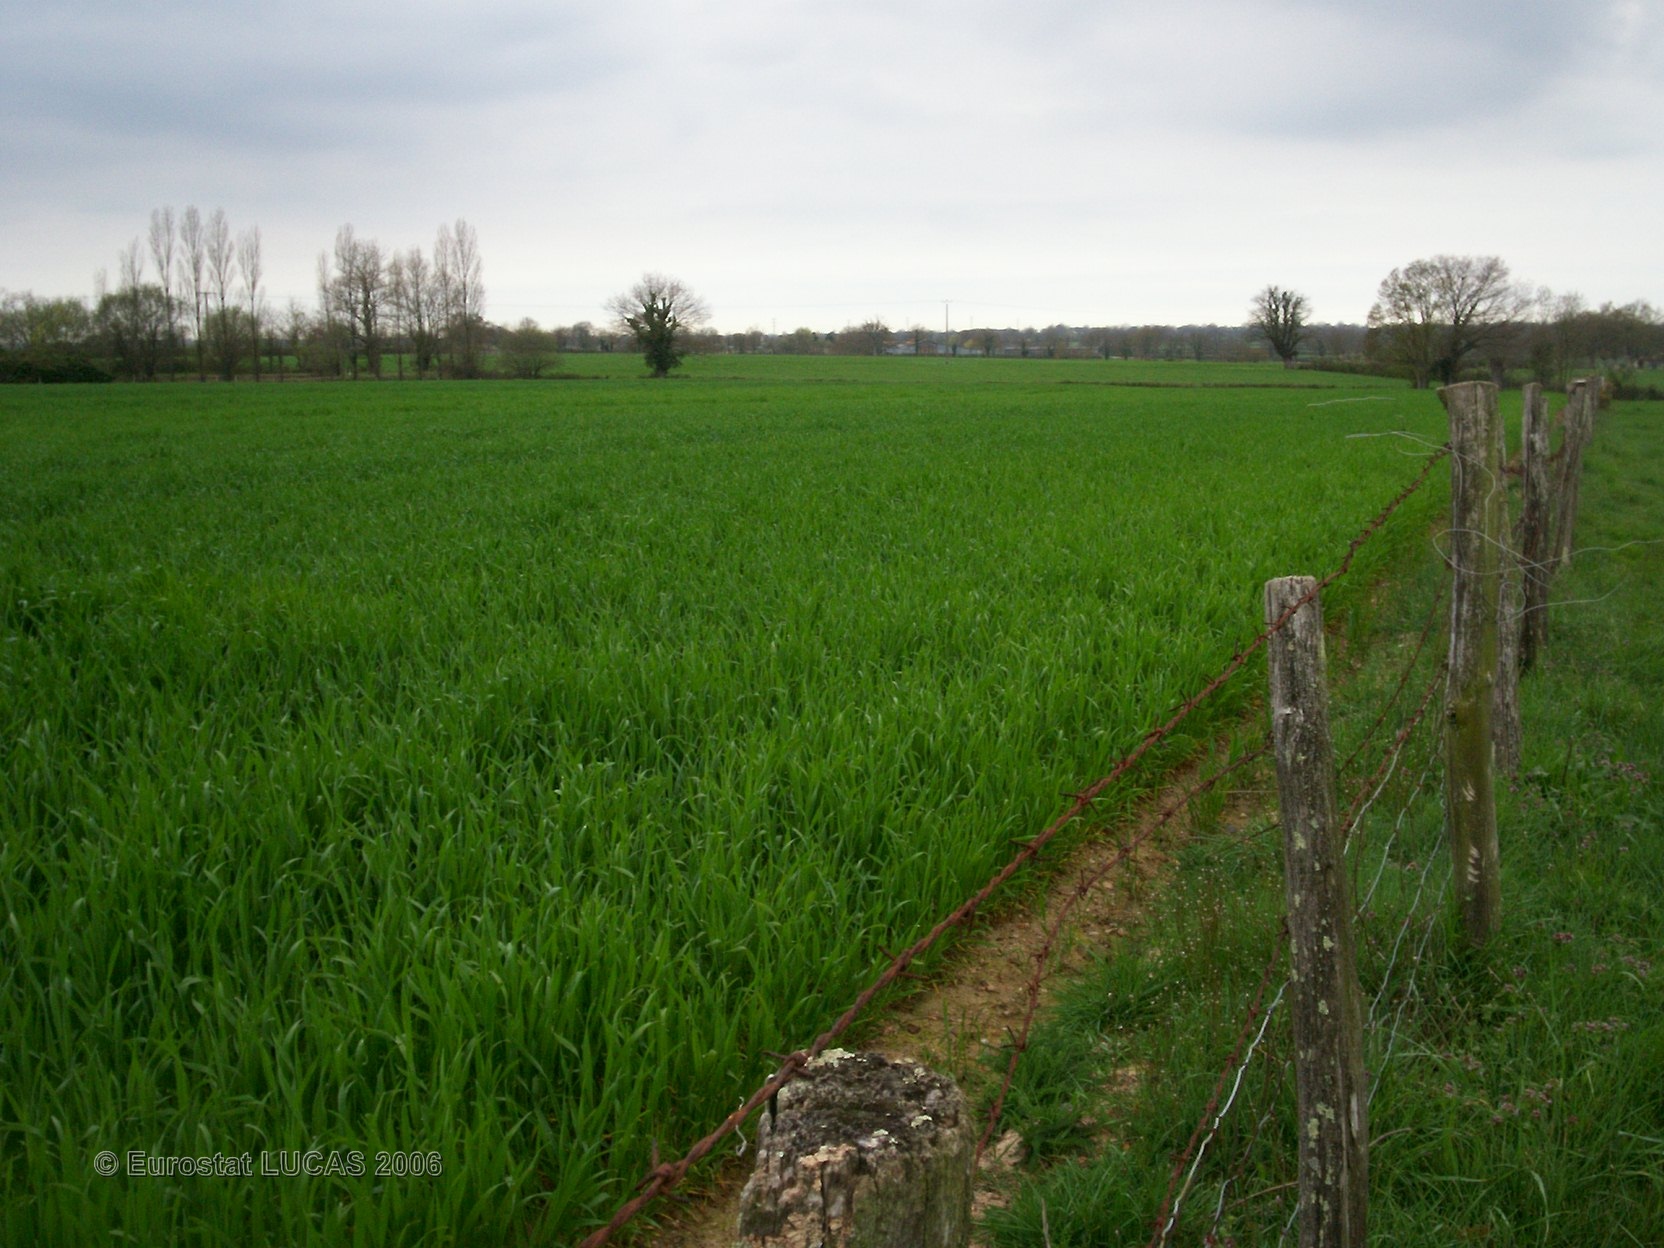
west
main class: Grassland
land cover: Grassland without tree/shrub cover
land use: Agriculture (excluding fallow land and kitchen gardens)
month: April
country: FR
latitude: 46.8438
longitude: -0.3730
